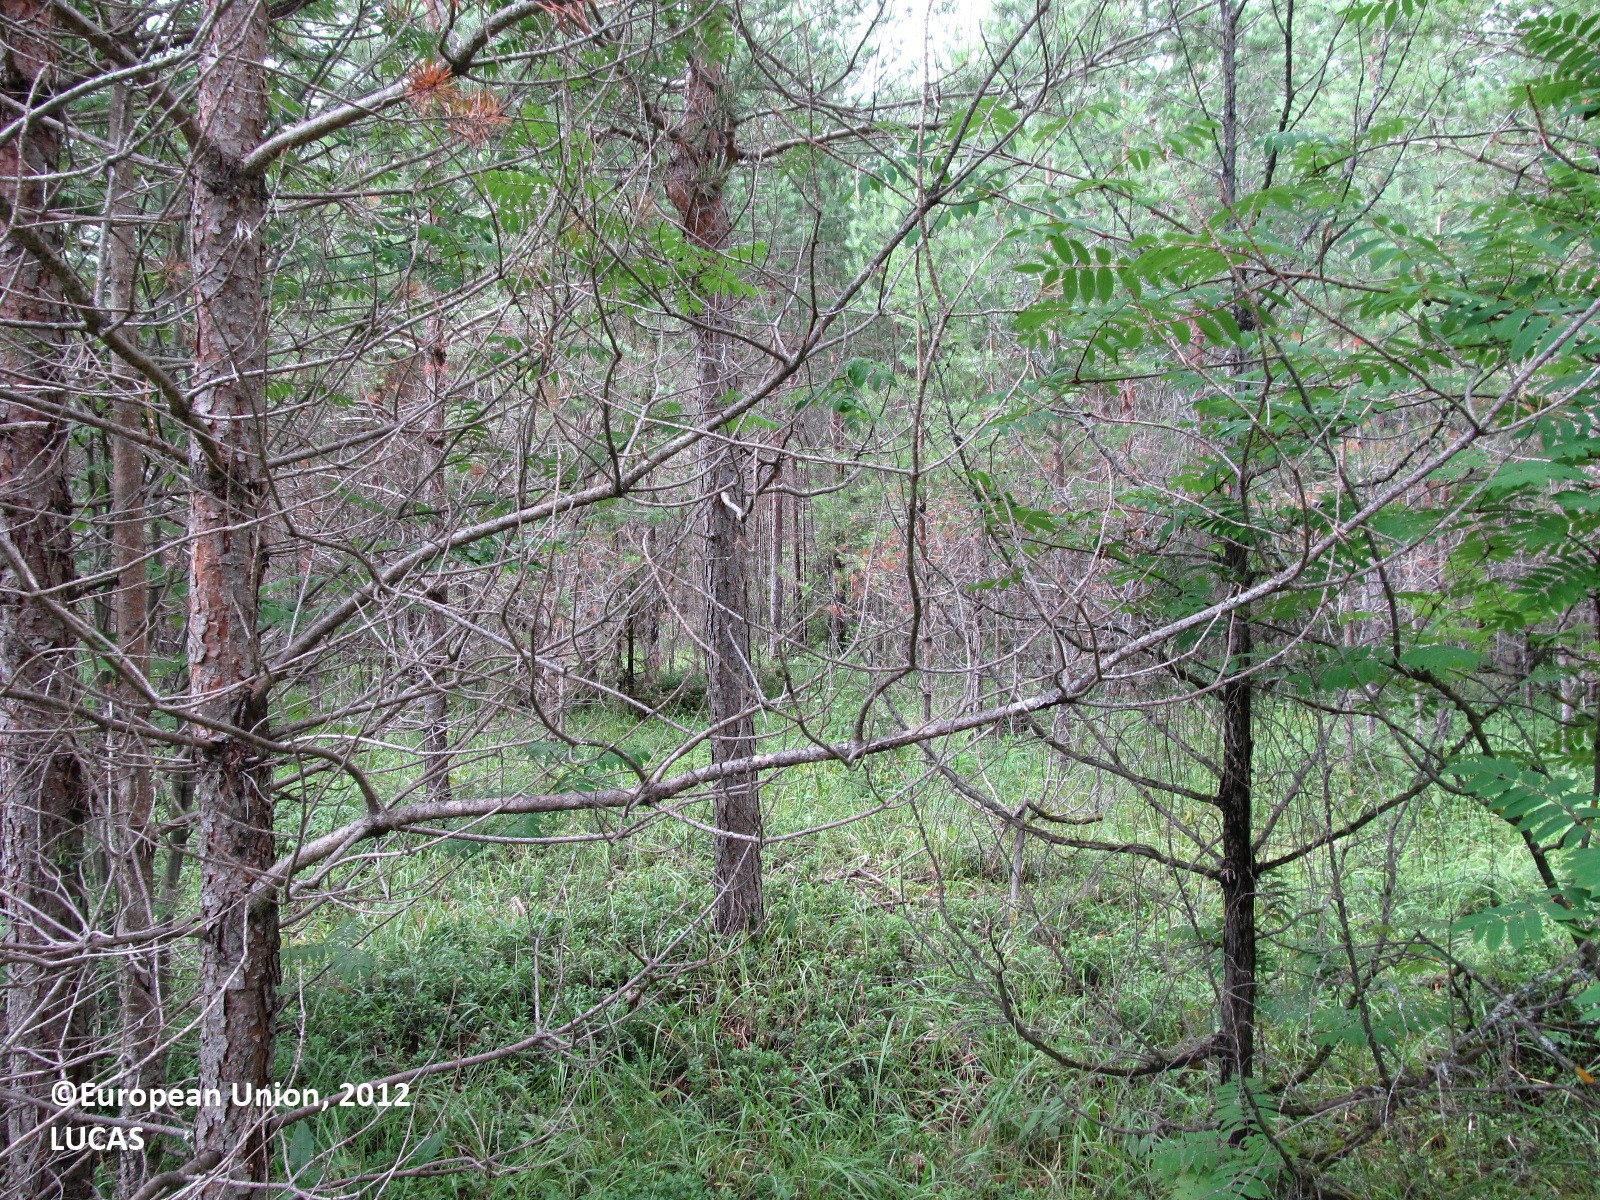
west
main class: Woodland
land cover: Pine dominated coniferous woodland
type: boreal forest
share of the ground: 25 - 50 %
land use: Forestry
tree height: > 5 m
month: July
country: FI
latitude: 61.9382
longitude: 29.0349
